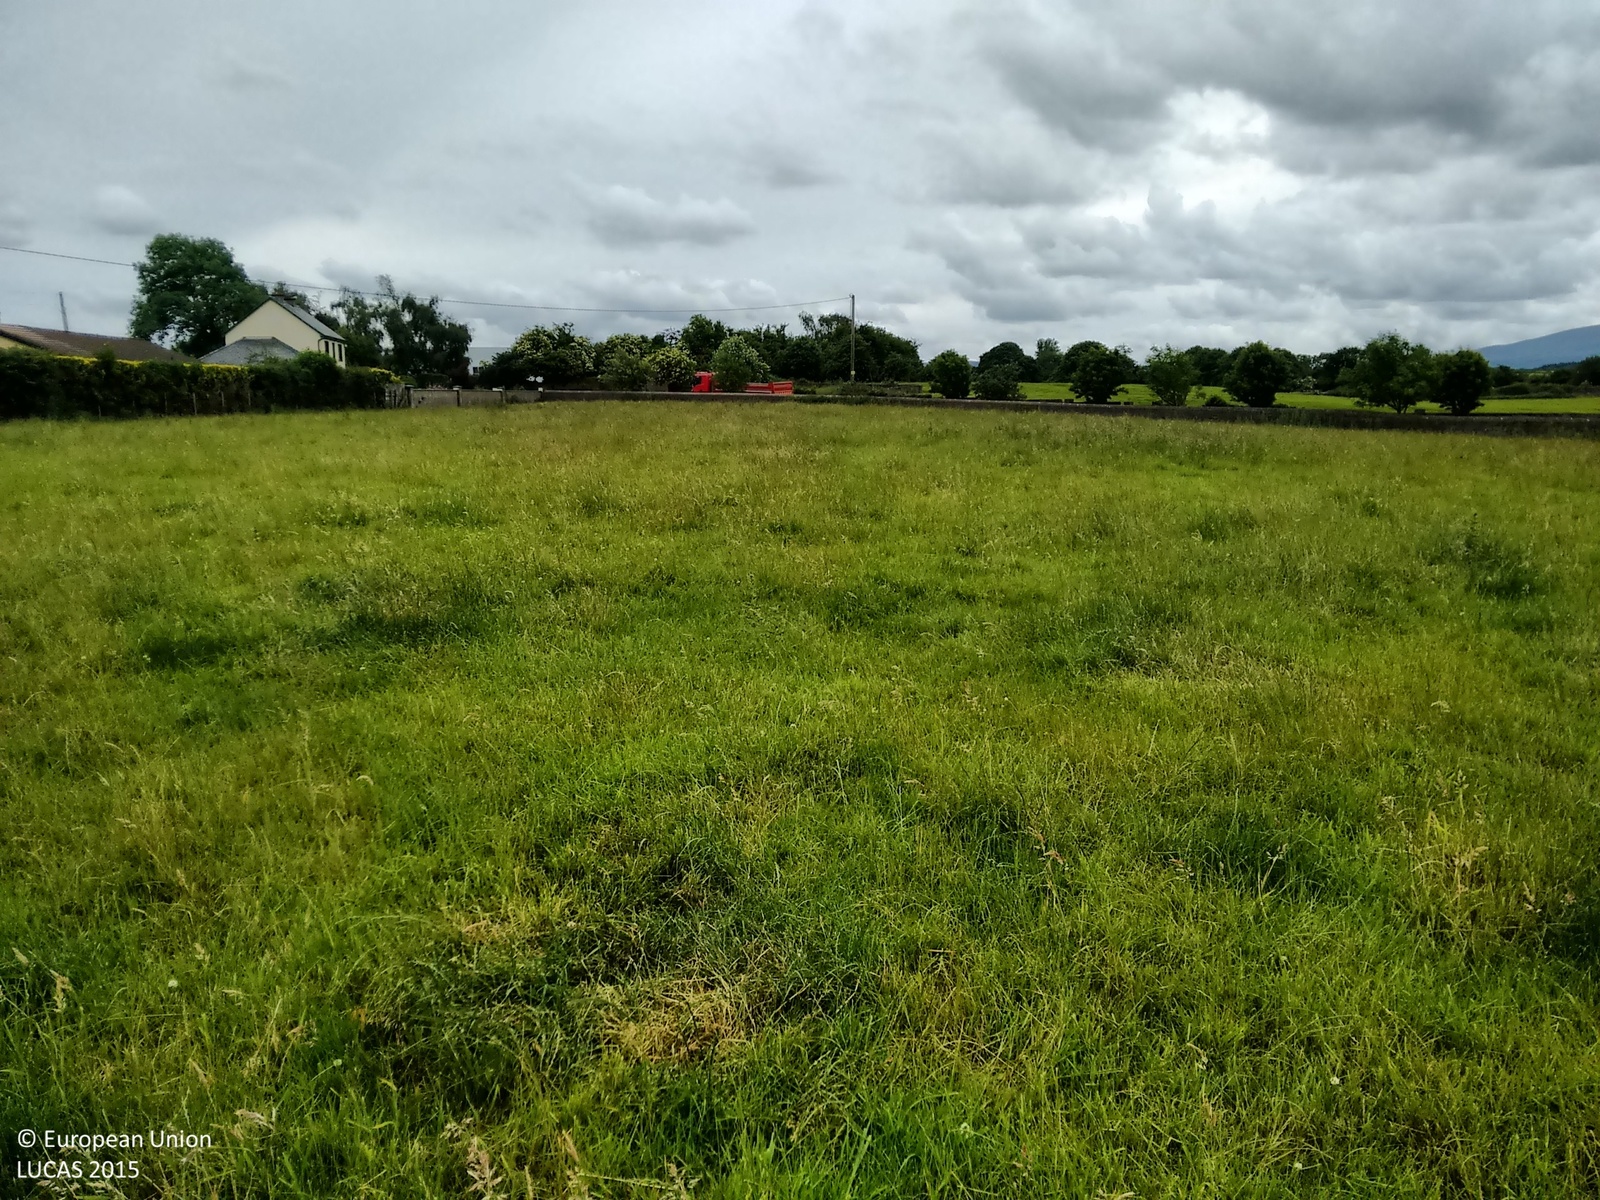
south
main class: Grassland
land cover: Grassland without tree/shrub cover
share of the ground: > 75 %
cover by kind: herbaceous plants 100 %
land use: Agriculture (excluding fallow land and kitchen gardens)
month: July
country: IE
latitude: 52.5518
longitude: -7.3961
